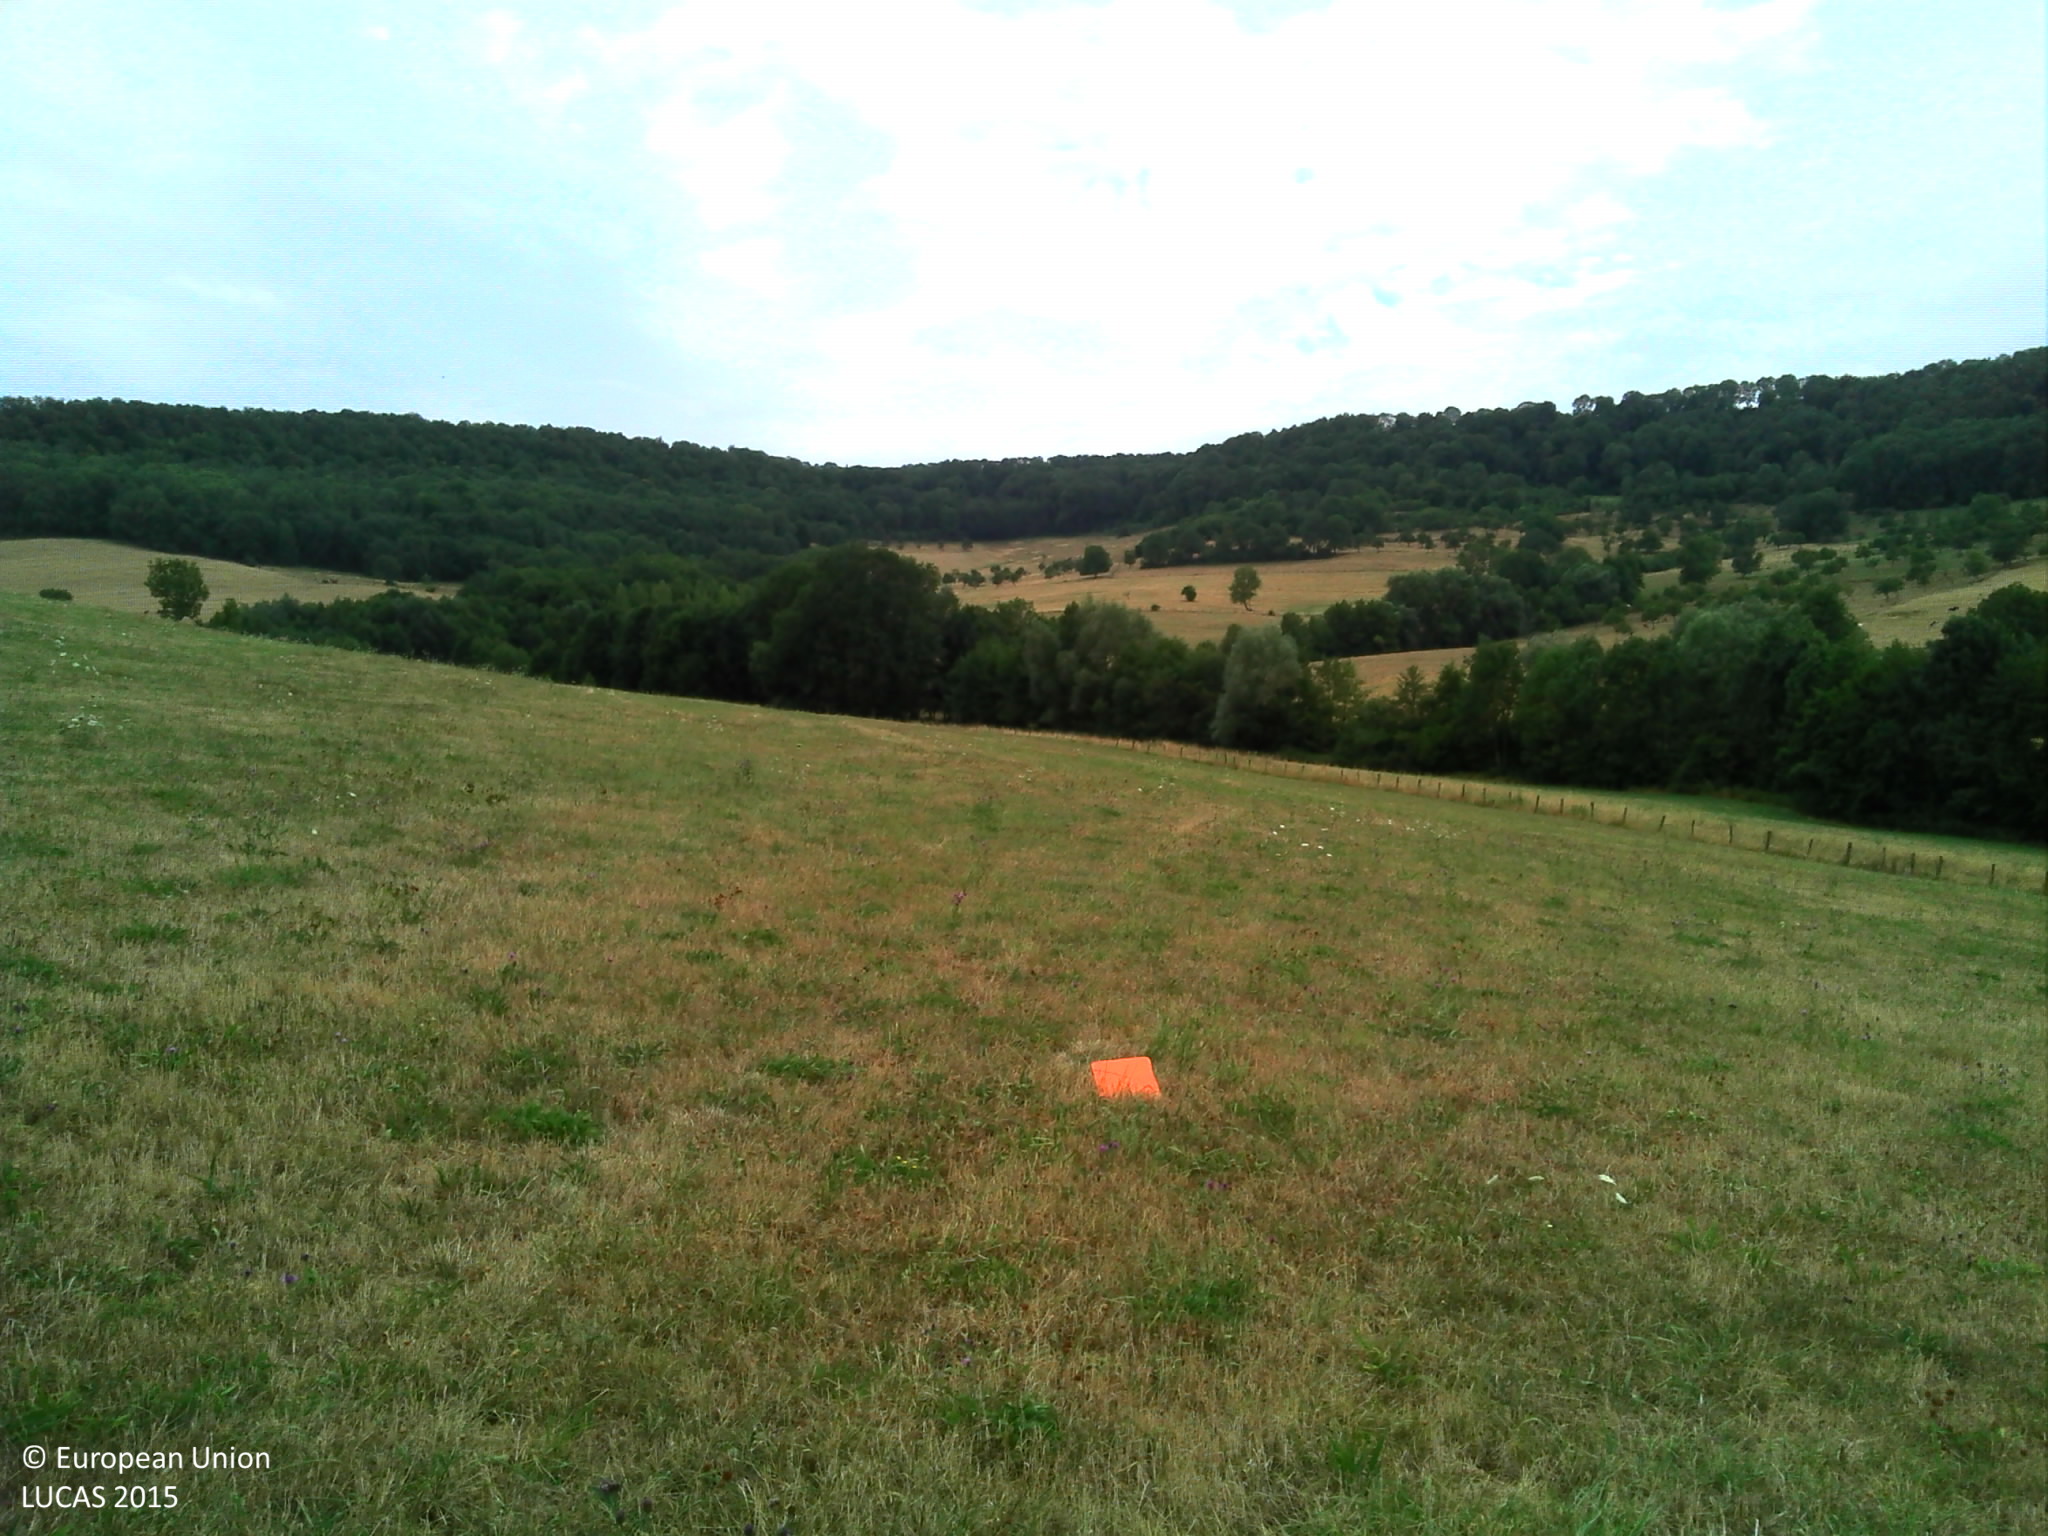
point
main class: Grassland
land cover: Grassland without tree/shrub cover
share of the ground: > 75 %
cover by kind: herbaceous plants 100 %
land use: Agriculture (excluding fallow land and kitchen gardens)
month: July
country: FR
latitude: 48.4237
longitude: 6.0677
